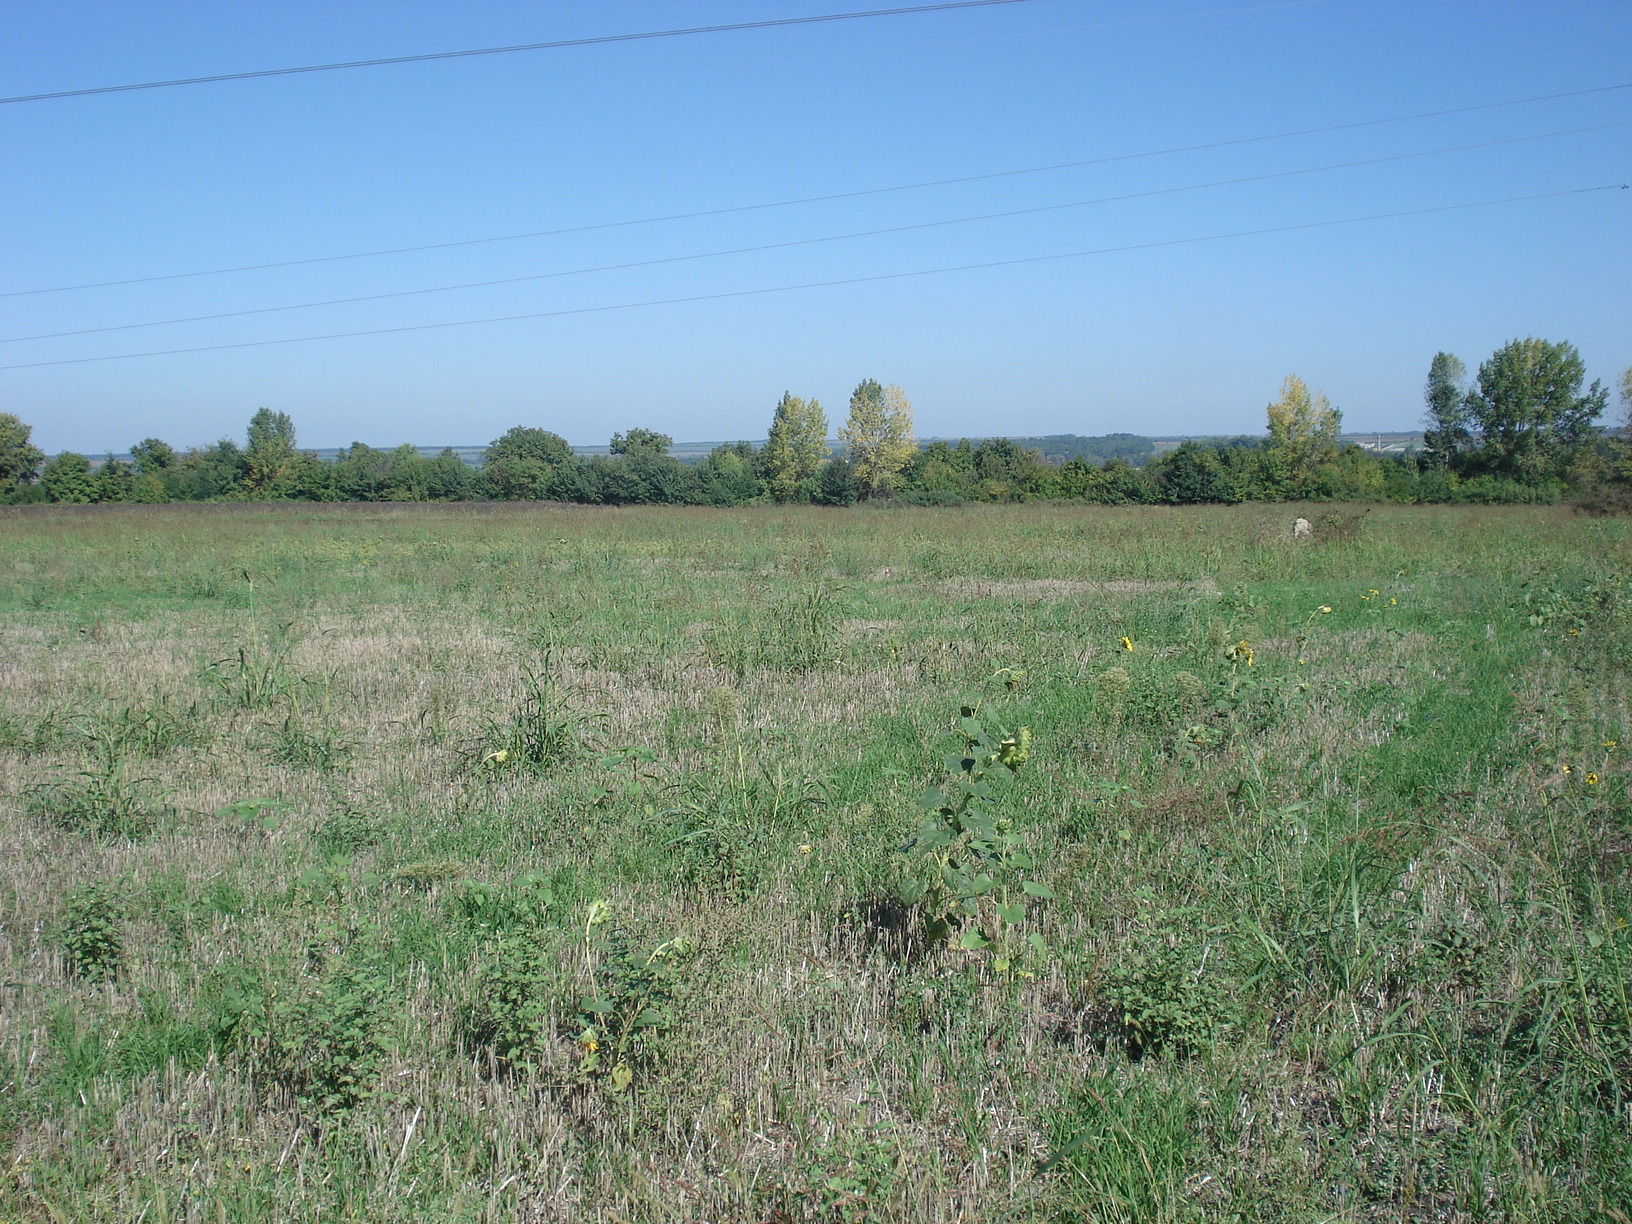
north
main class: Cropland
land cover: Common wheat
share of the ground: < 10 %
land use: Agriculture (excluding fallow land and kitchen gardens)
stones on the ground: < 10 %
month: October
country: BG
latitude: 43.2293
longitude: 25.2800
